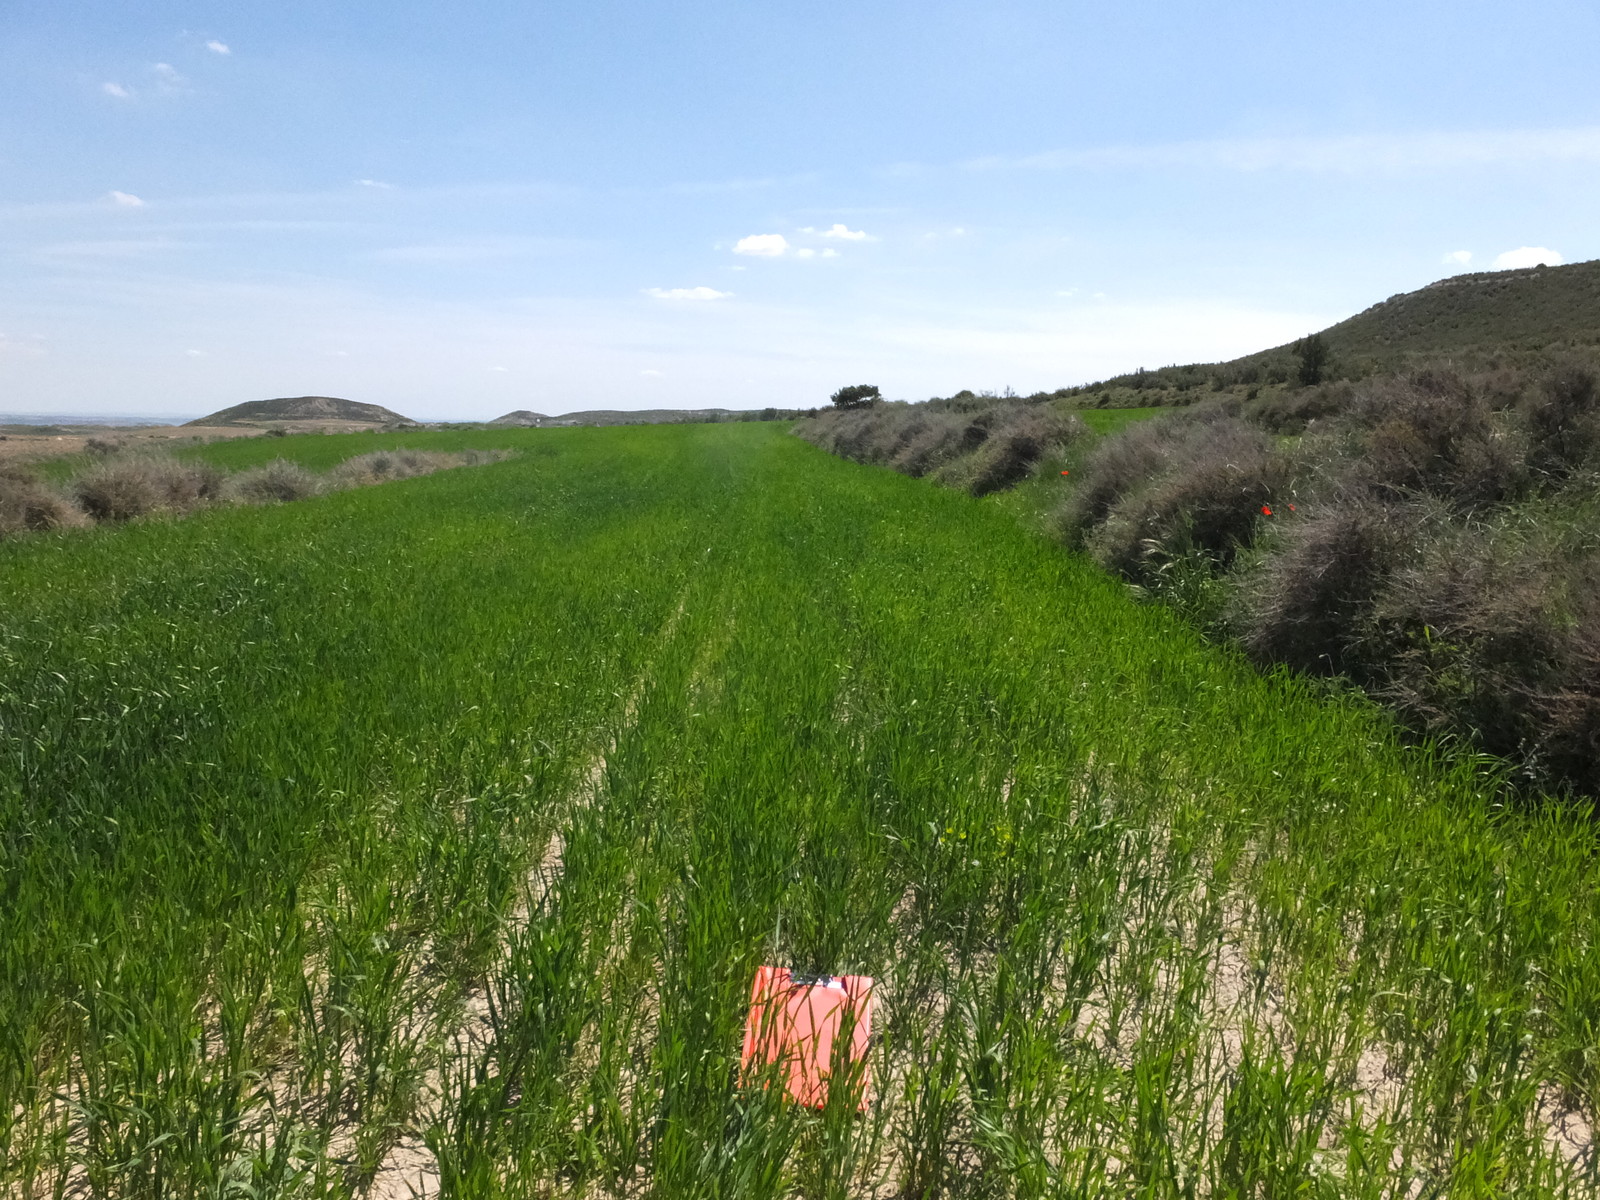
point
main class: Cropland
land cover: Durum wheat
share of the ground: > 75 %
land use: Agriculture (excluding fallow land and kitchen gardens)
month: April
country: ES
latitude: 41.6276
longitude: -0.2075
